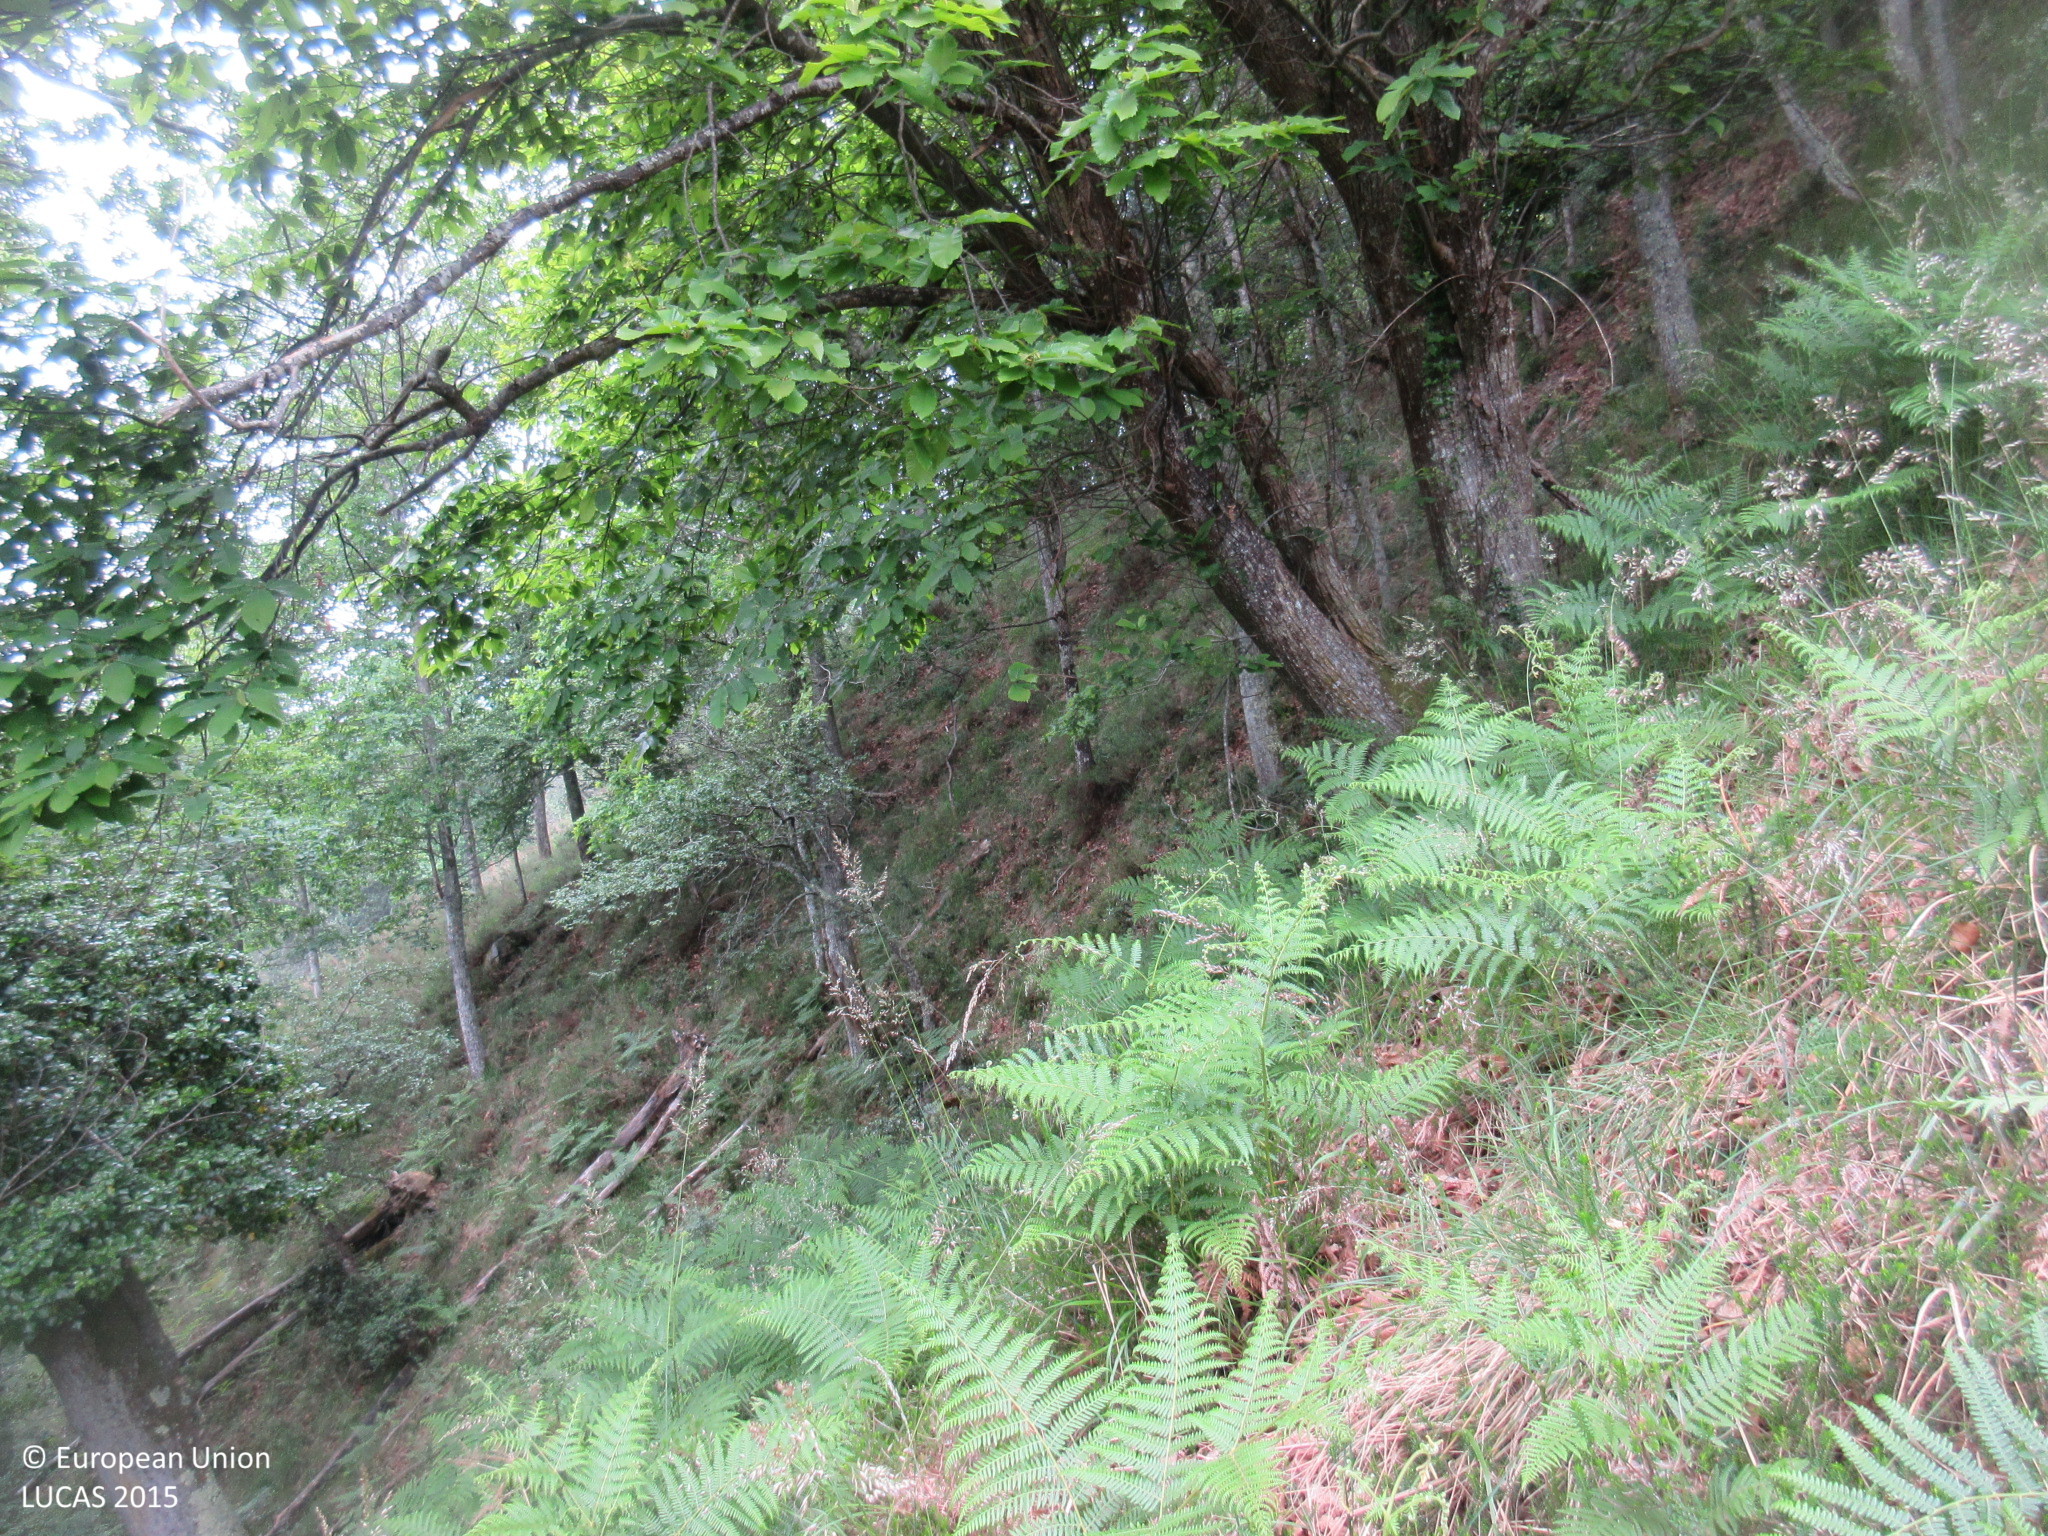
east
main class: Woodland
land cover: Broadleaved woodland
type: acidophilous oak and oak-birch forest
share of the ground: 50 - 75 %
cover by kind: broadleaved forest trees 70 %, shrubs 30 %
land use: Semi-natural and natural areas not in use
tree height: > 5 m
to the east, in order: Broadleaved woodland
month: June
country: ES
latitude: 43.2220
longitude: -4.1990
